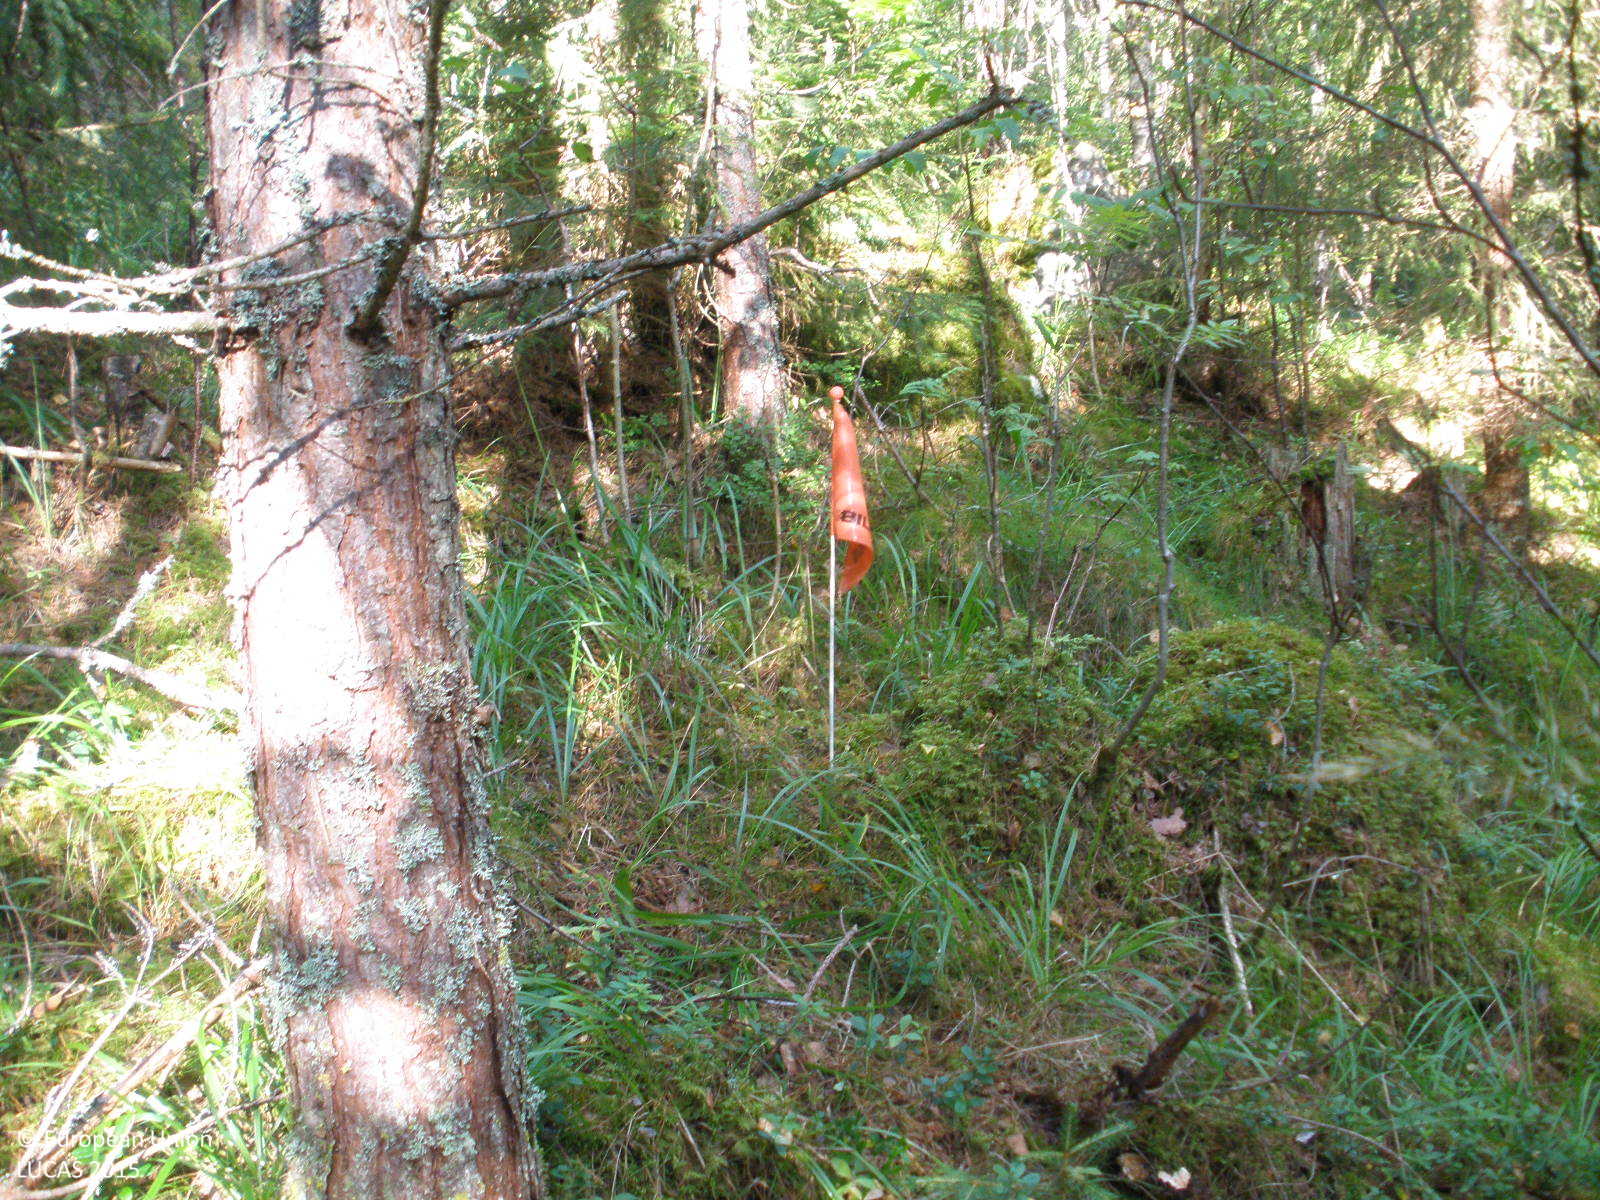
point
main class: Woodland
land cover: Pine dominated mixed woodland
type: boreal forest
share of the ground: > 75 %
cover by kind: coniferous forest trees 60 %, broadleaved forest trees 25 %, lichens and mosses 10 %, herbaceous plants 5 %
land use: Forestry
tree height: > 5 m
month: August
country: FI
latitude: 60.9138
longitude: 24.8450
